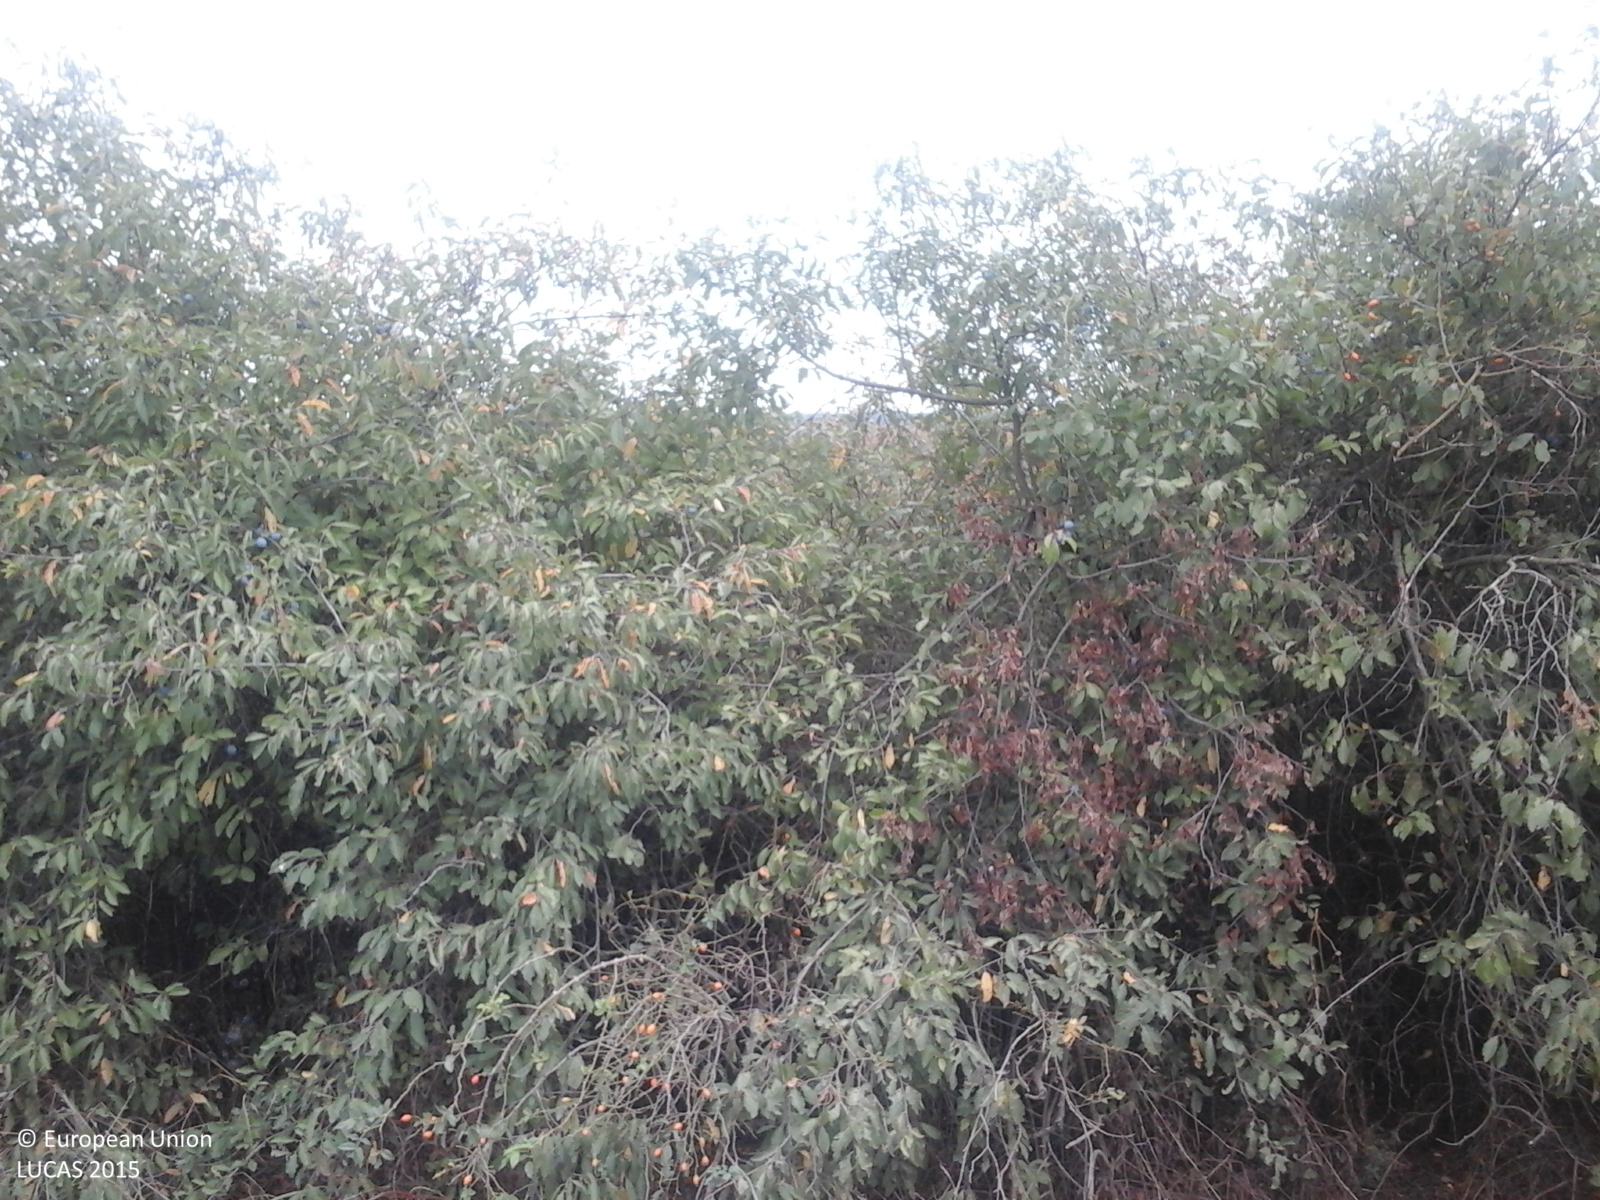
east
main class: Shrubland
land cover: Shrubland without tree cover
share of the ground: > 75 %
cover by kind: shrubs 100 %
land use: Semi-natural and natural areas not in use
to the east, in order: Shrubland without tree cover; Ditches and canals; Spontaneously vegetated surfaces
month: September
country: RO
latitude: 47.6531
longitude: 22.6687
